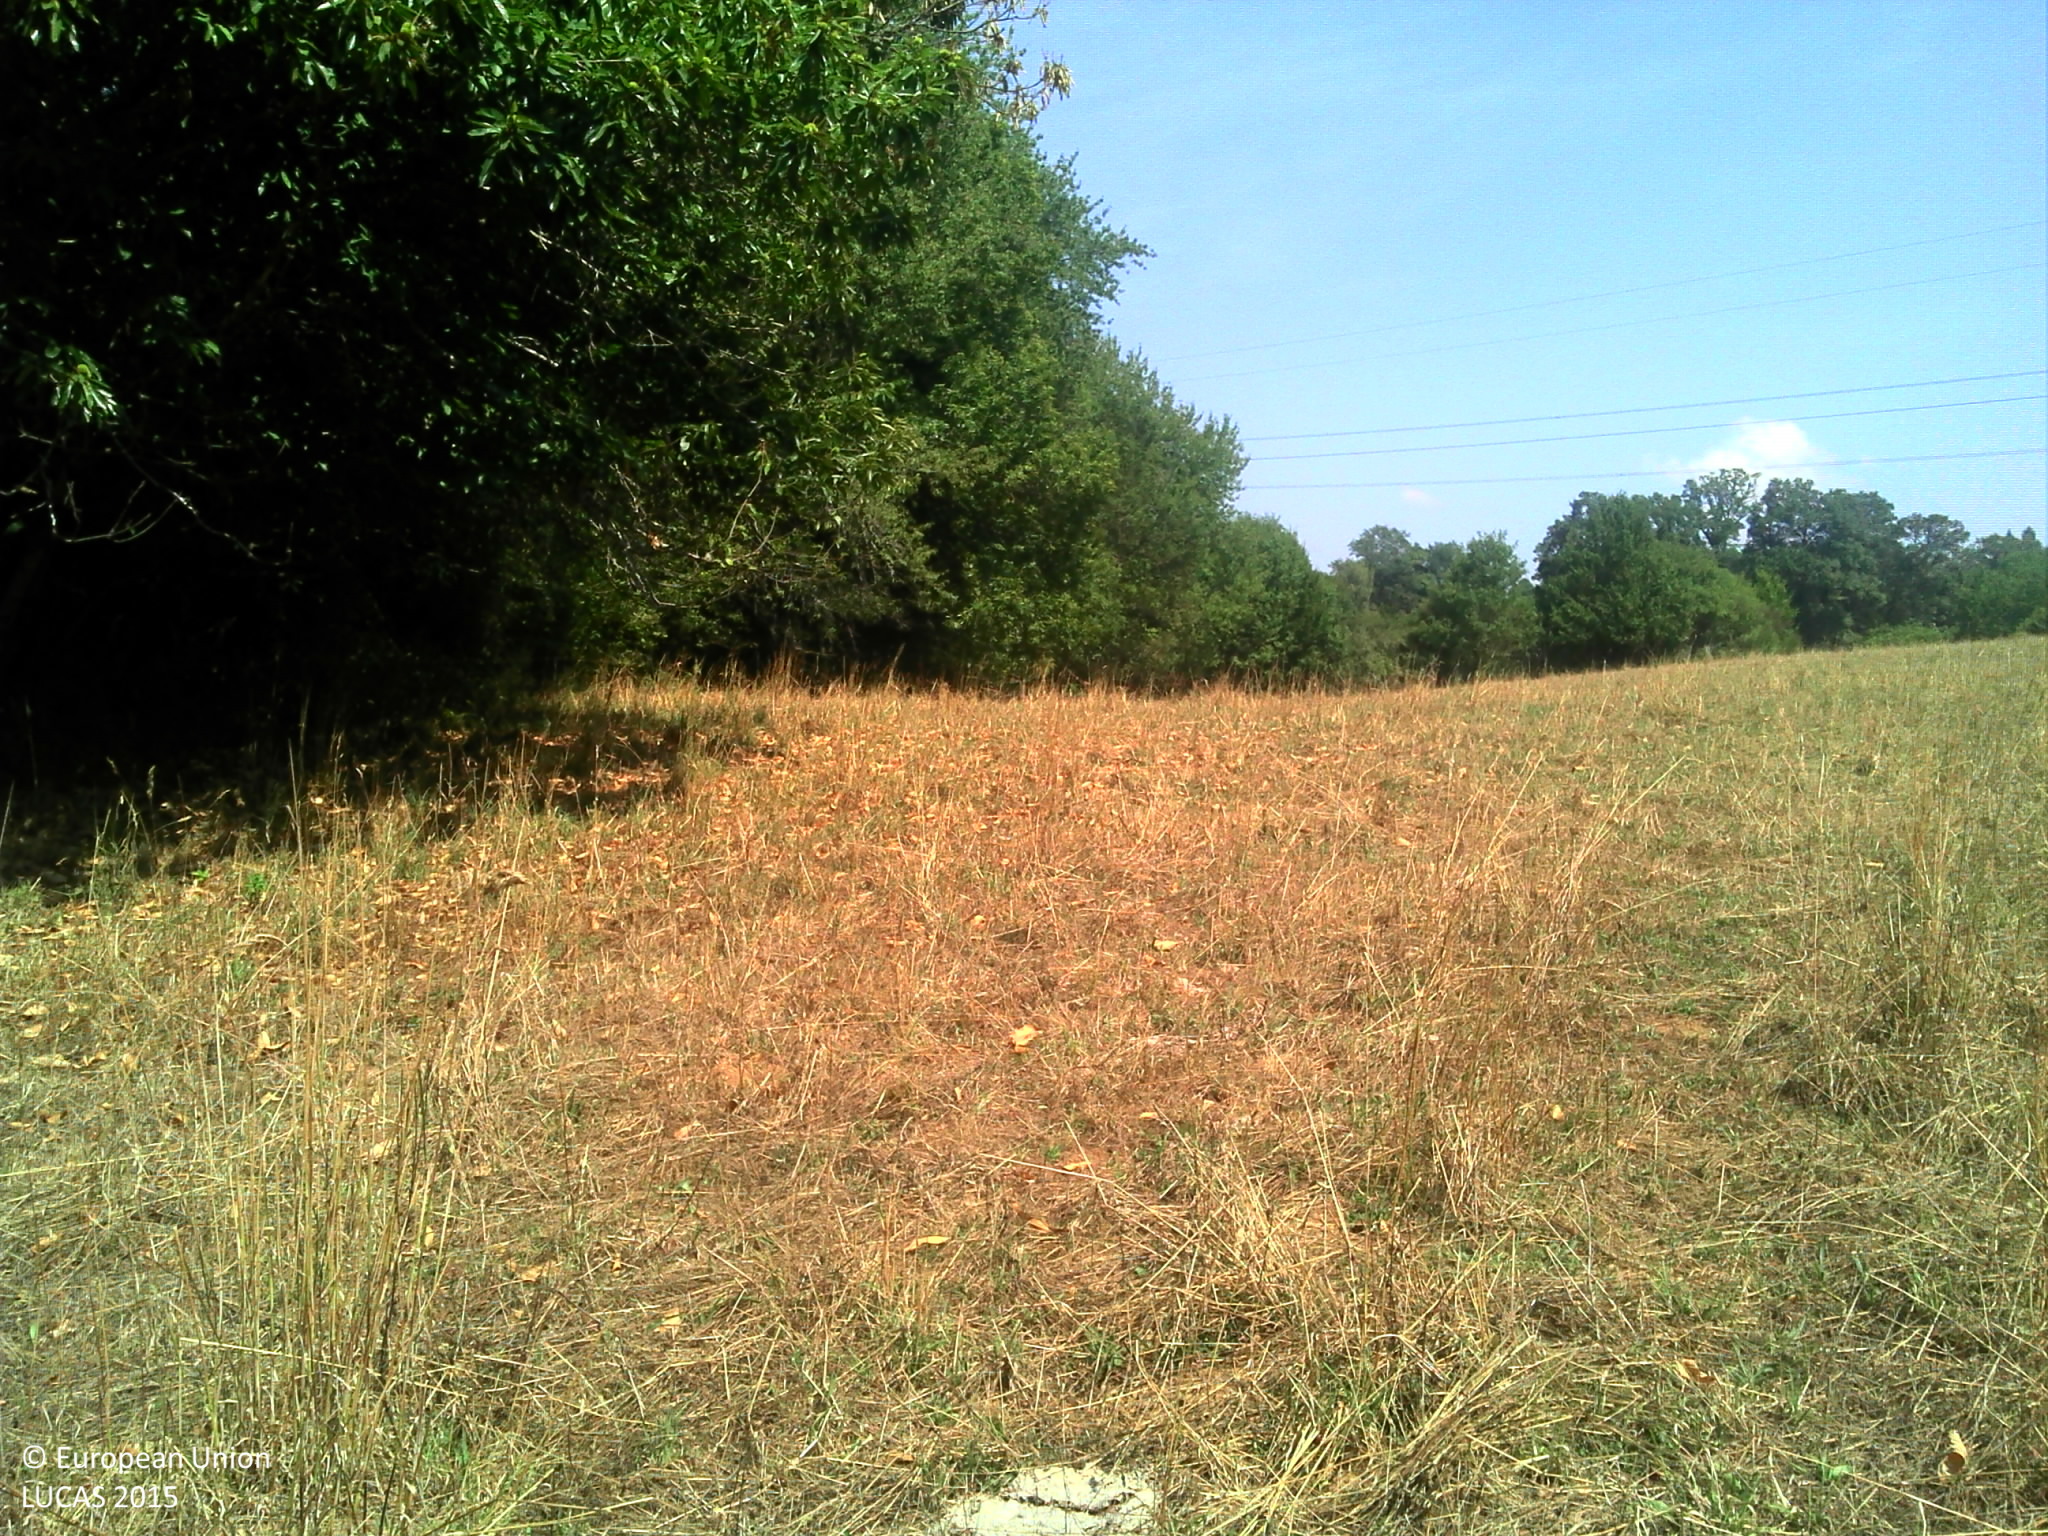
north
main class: Grassland
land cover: Grassland without tree/shrub cover
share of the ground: > 75 %
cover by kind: herbaceous plants 100 %
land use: Agriculture (excluding fallow land and kitchen gardens)
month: August
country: FR
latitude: 45.4188
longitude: 1.7784
